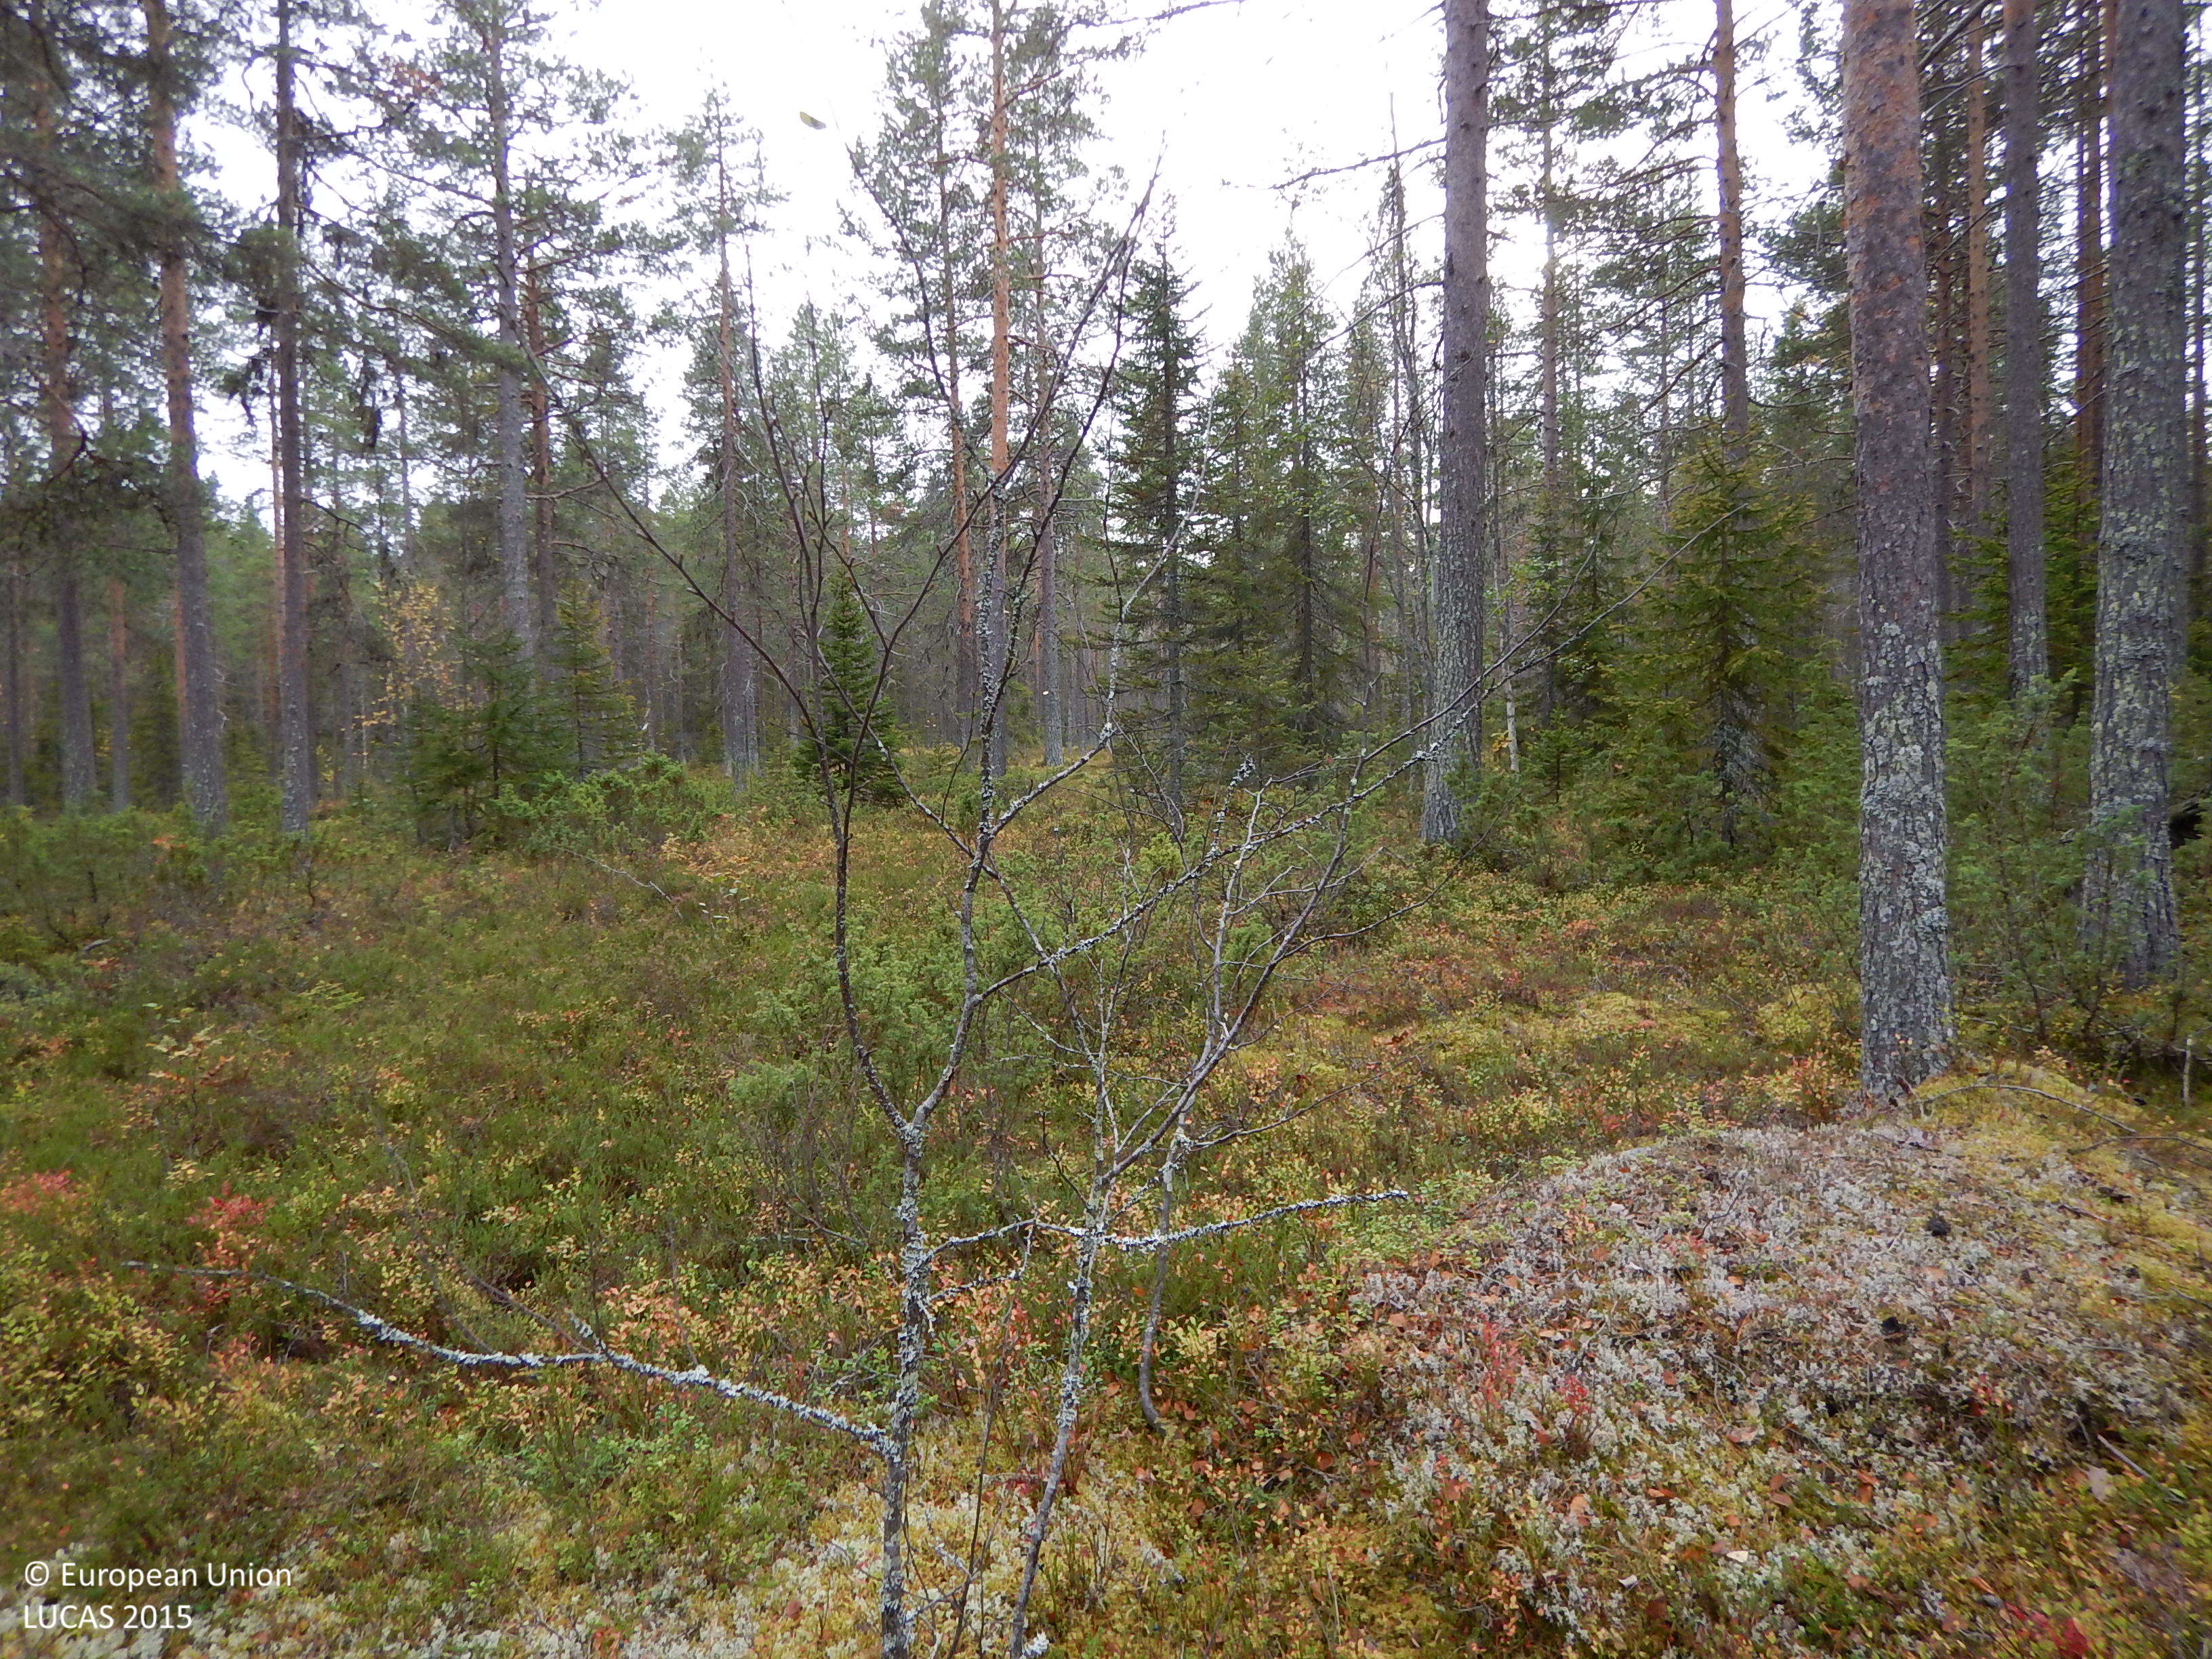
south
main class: Woodland
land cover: Pine dominated coniferous woodland
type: boreal forest
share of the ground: 50 - 75 %
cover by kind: coniferous forest trees 55 %, shrubs 20 %, herbaceous plants 10 %, lichens and mosses 10 %, broadleaved forest trees 5 %
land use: Forestry
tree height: > 5 m
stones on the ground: < 10 %
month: October
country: SE
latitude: 64.8566
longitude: 20.7118
